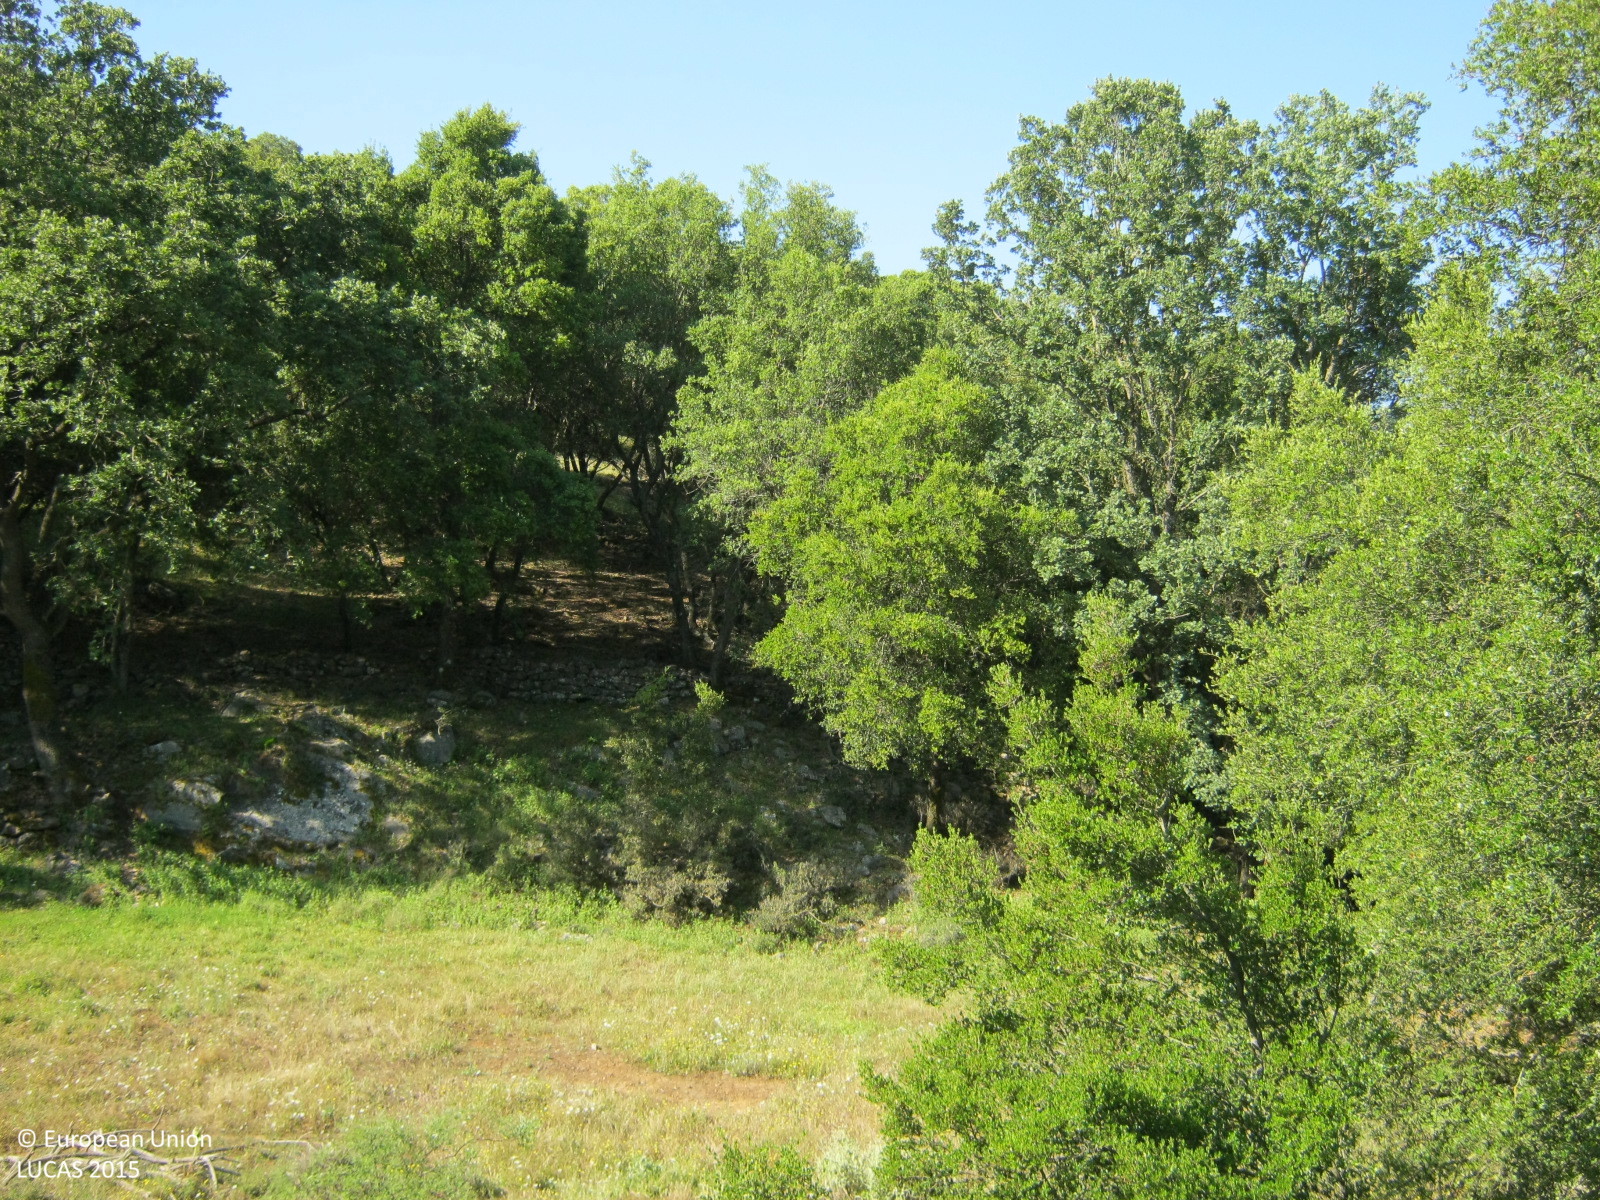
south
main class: Woodland
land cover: Broadleaved woodland
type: broadleaved evergreen forest
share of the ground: > 75 %
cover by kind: broadleaved forest trees 90 %, coniferous forest trees 5 %, herbaceous plants 5 %
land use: Semi-natural and natural areas not in use
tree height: > 5 m
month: June
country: GR
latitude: 35.3397
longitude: 24.8547
